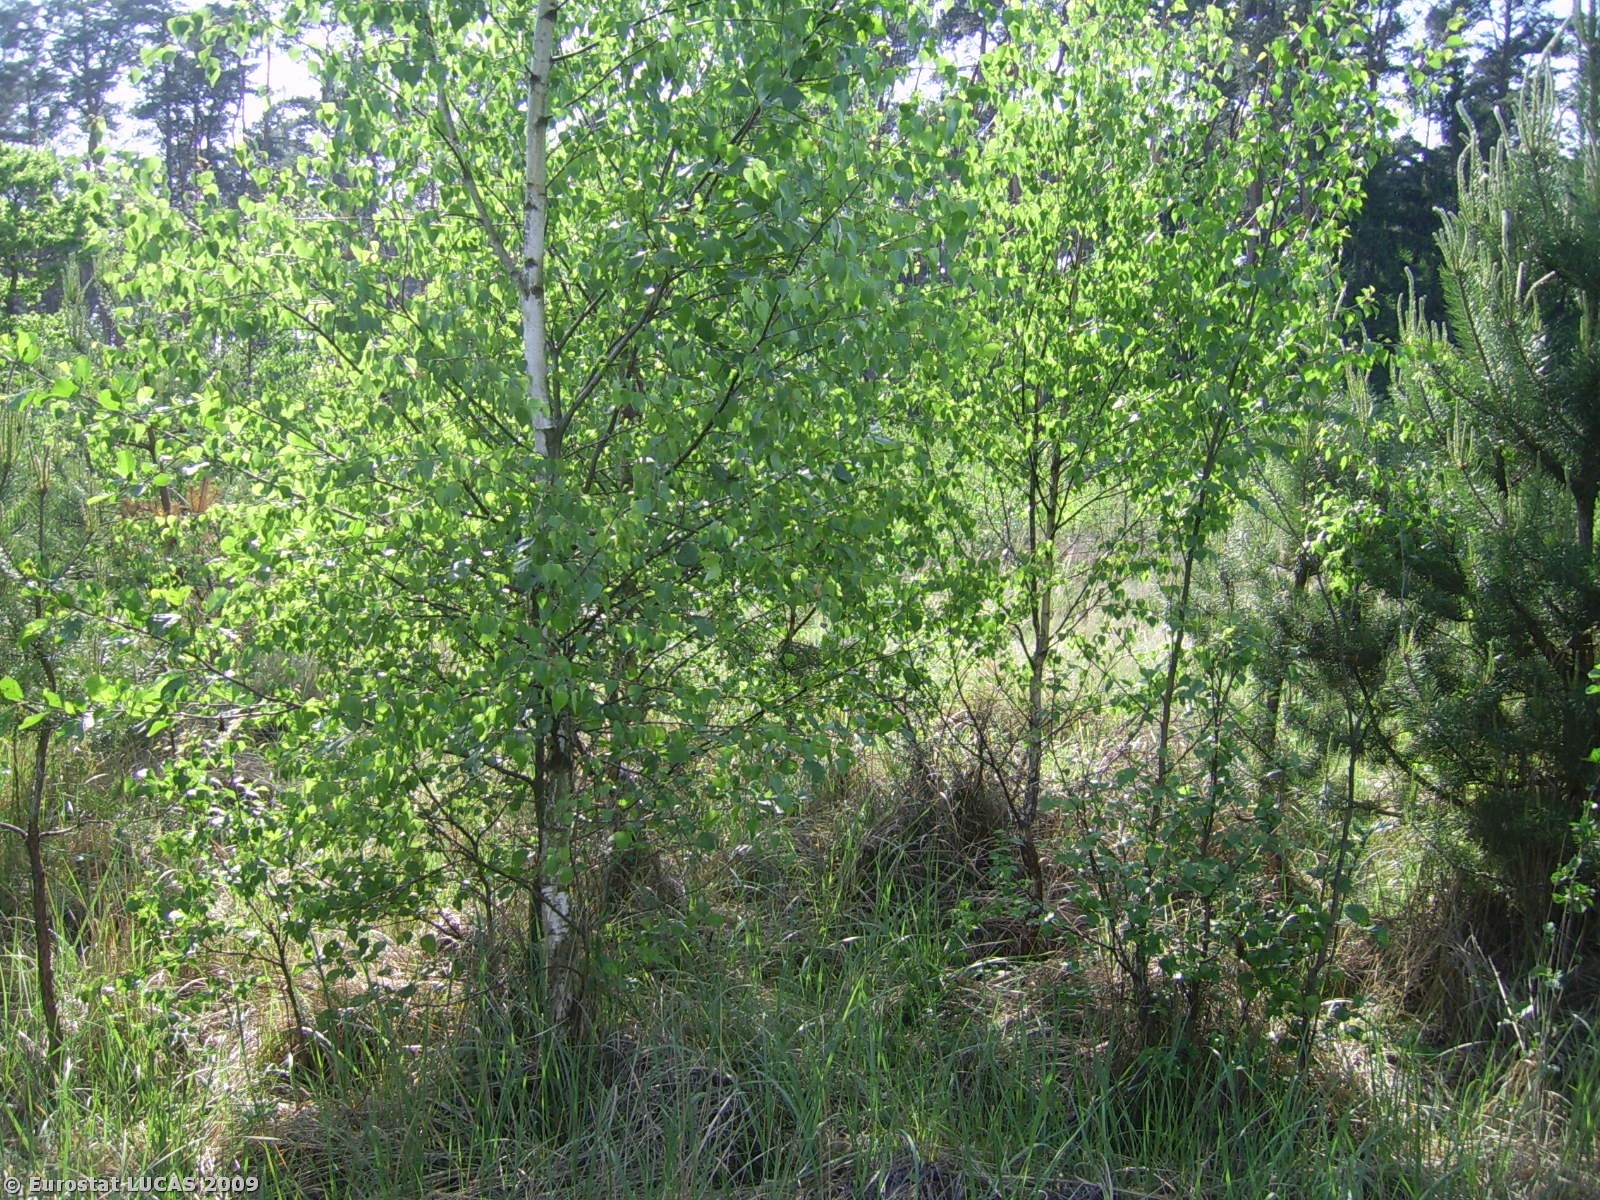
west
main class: Woodland
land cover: Mixed woodland
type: hemiboreal forest and nemoral coniferous forest and mixed broadleaved-coniferous forest
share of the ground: > 75 %
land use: Forestry
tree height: > 5 m
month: May
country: PL
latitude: 52.9795
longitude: 18.1931
